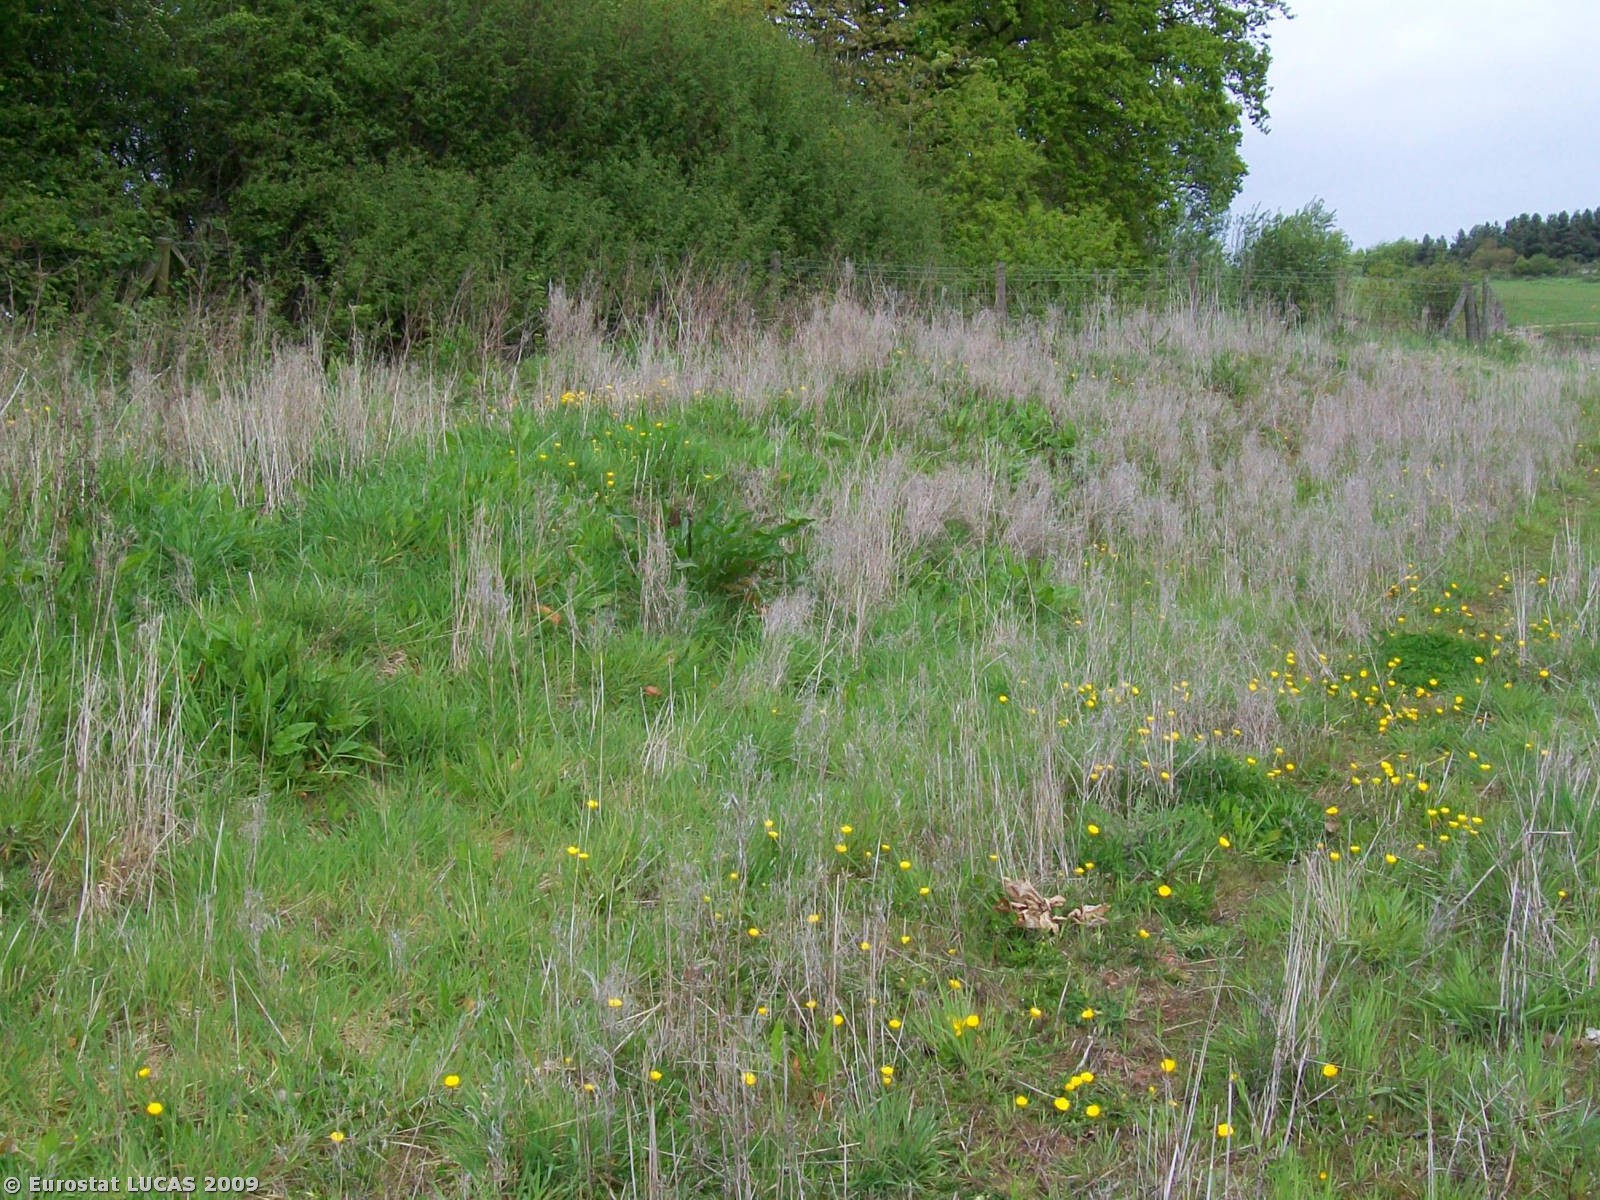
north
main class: Grassland
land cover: Grassland without tree/shrub cover
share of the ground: > 75 %
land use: Agriculture (excluding fallow land and kitchen gardens)
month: May
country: GB
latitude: 52.4242
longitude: -2.4923
